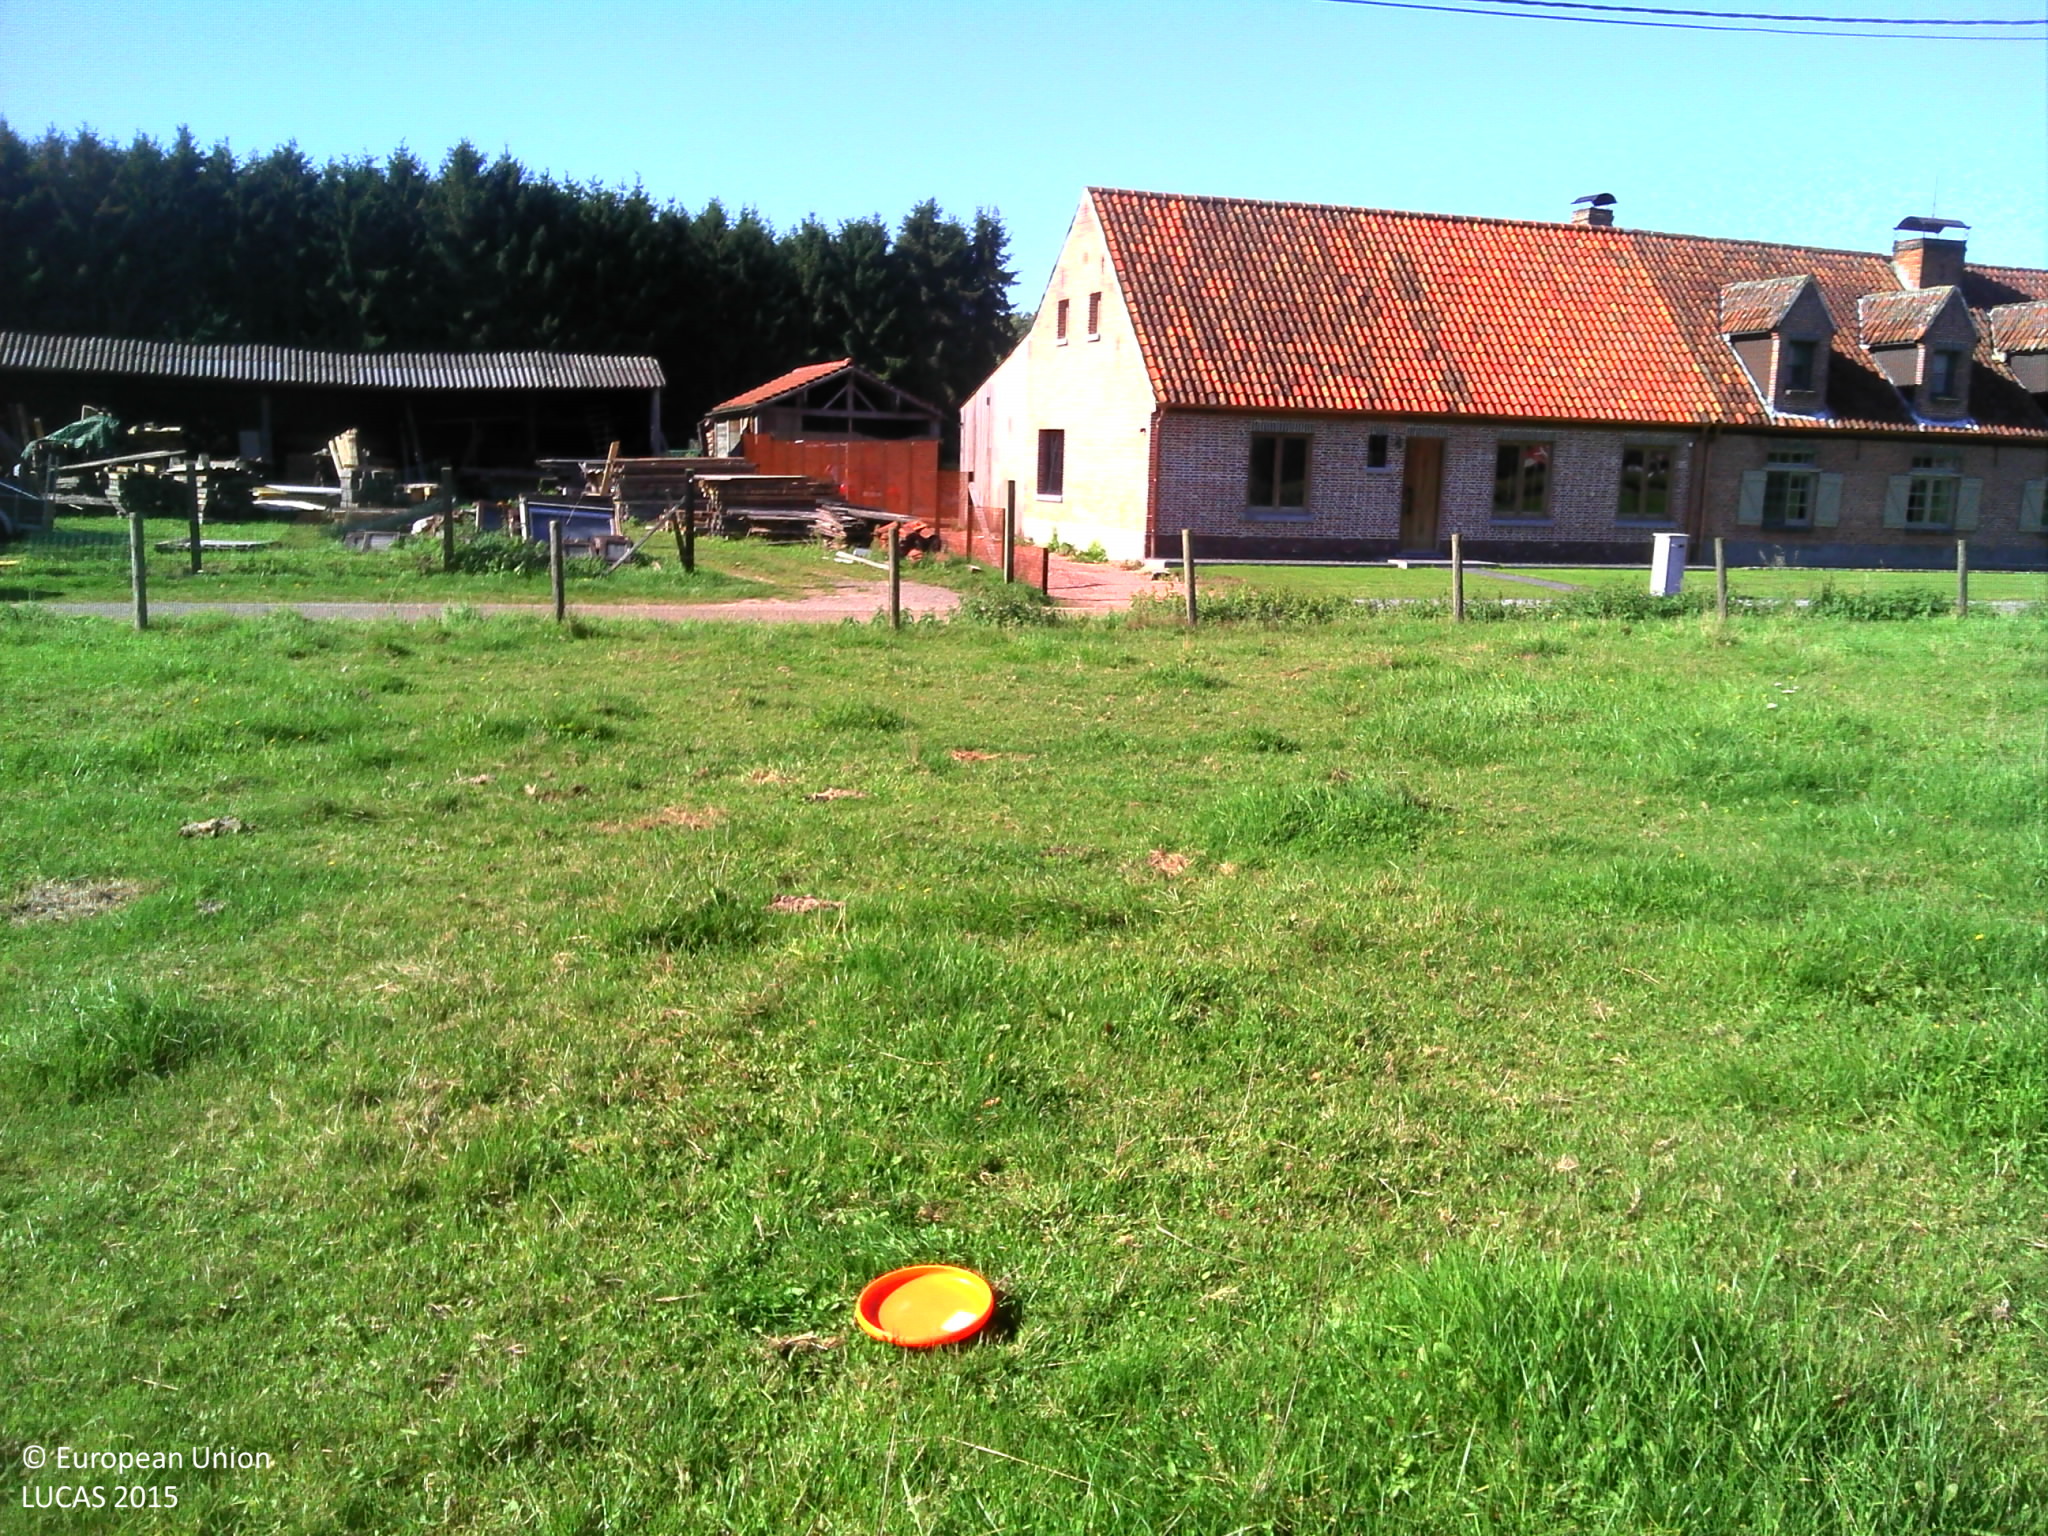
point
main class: Grassland
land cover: Grassland without tree/shrub cover
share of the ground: > 75 %
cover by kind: herbaceous plants 100 %
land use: Agriculture (excluding fallow land and kitchen gardens)
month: September
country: BE
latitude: 51.2546
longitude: 4.7953
